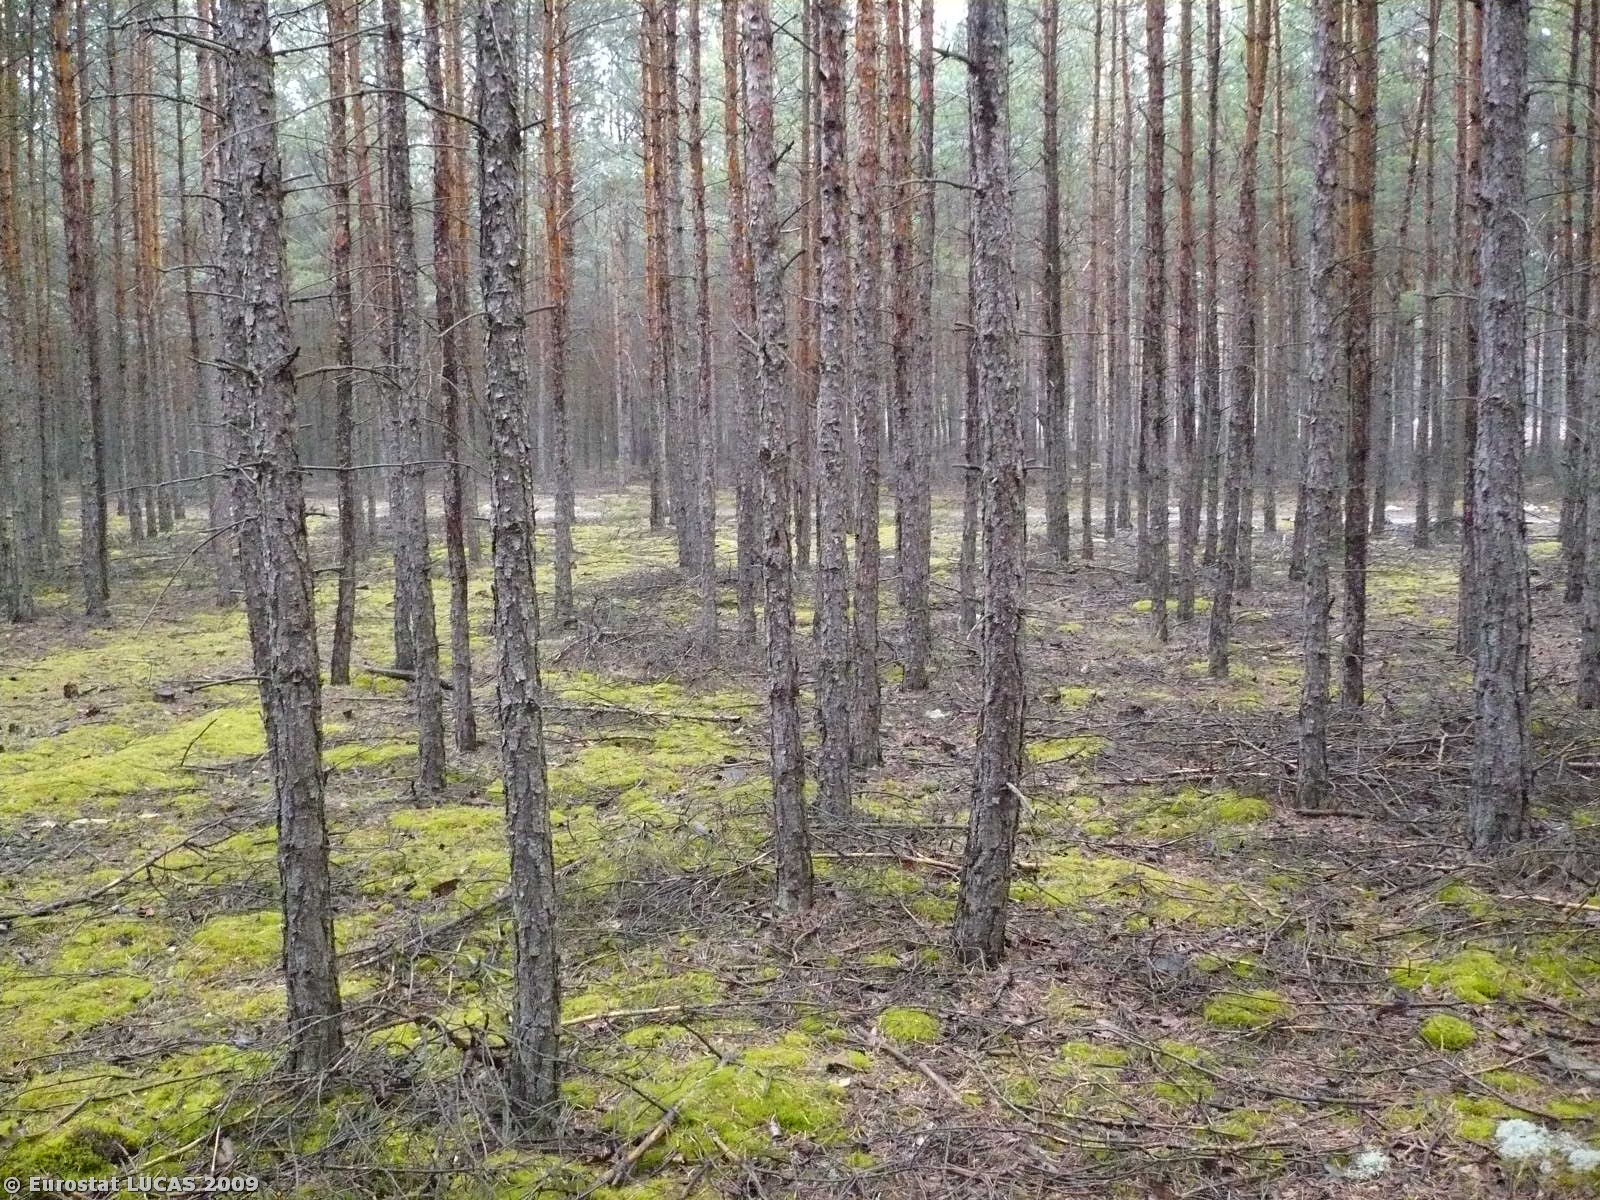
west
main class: Woodland
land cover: Coniferous woodland
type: hemiboreal forest and nemoral coniferous forest and mixed broadleaved-coniferous forest
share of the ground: > 75 %
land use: Forestry
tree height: > 5 m
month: May
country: PL
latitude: 51.7398
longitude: 15.2314
